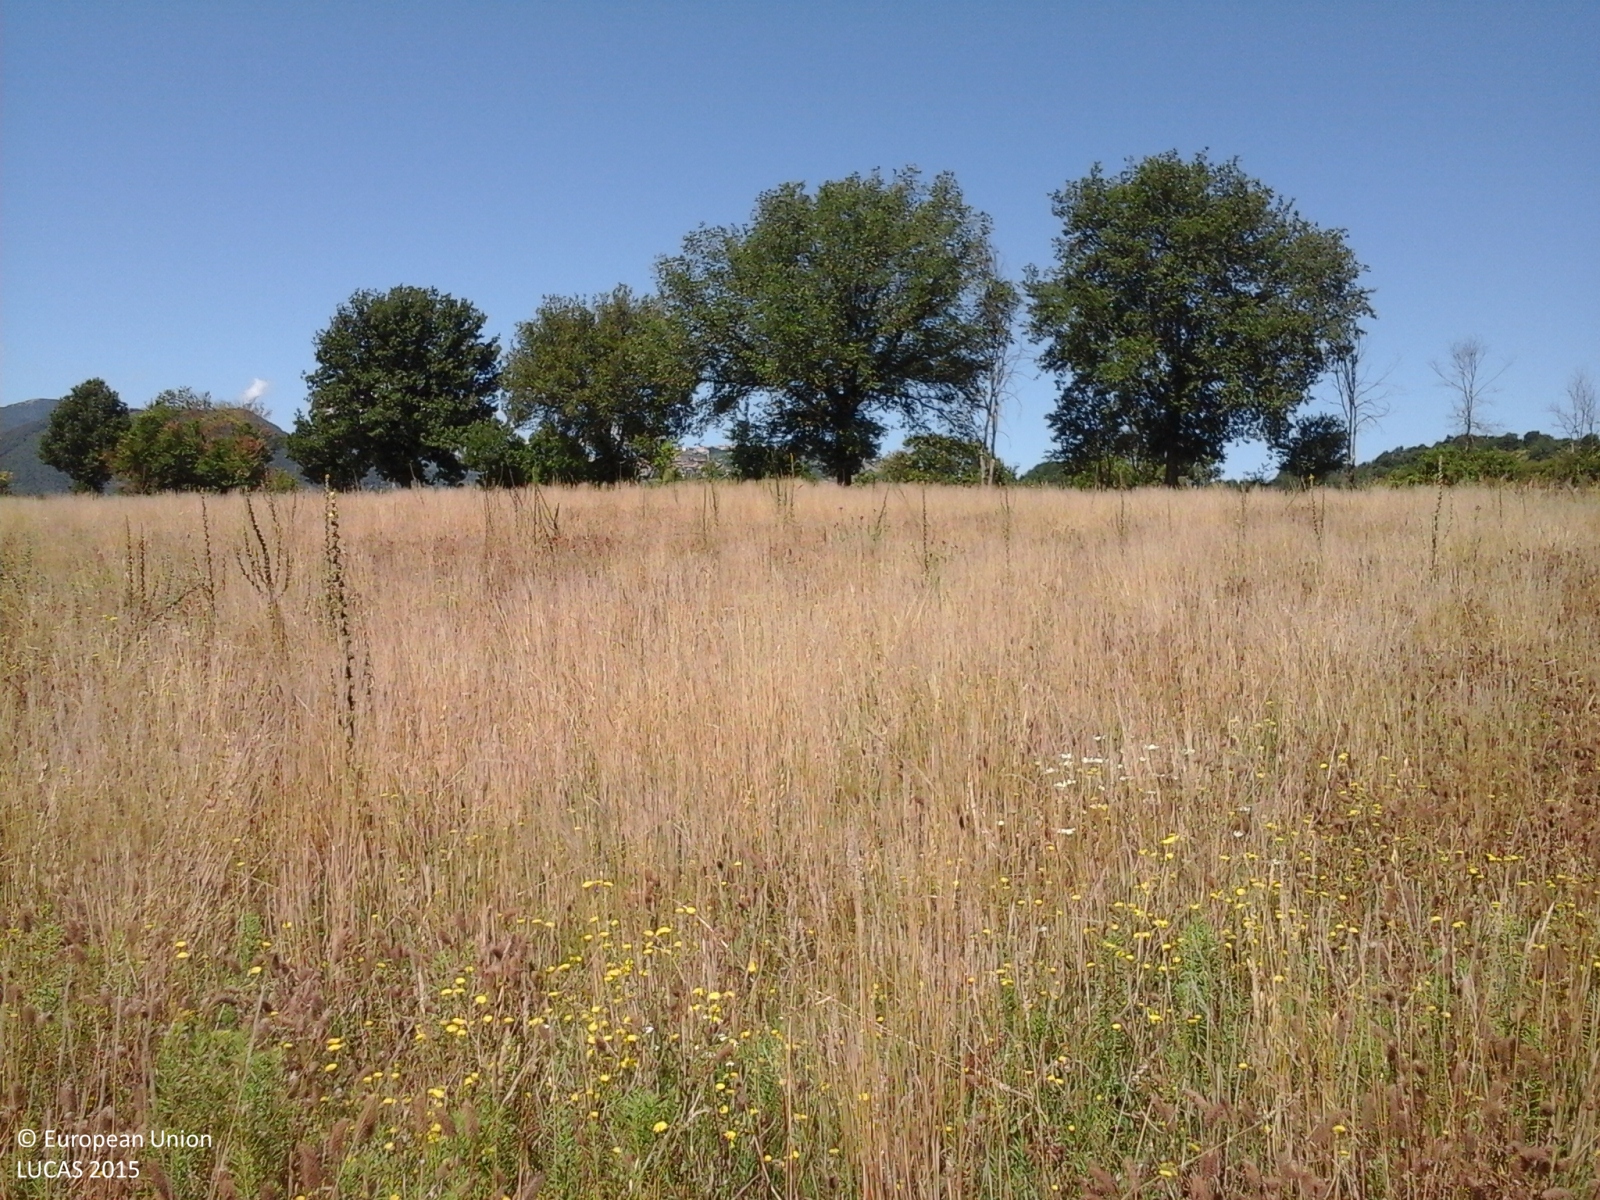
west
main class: Grassland
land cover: Grassland without tree/shrub cover
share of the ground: > 75 %
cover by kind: herbaceous plants 100 %
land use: Agriculture (excluding fallow land and kitchen gardens)
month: June
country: IT
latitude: 41.7033
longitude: 13.0768
